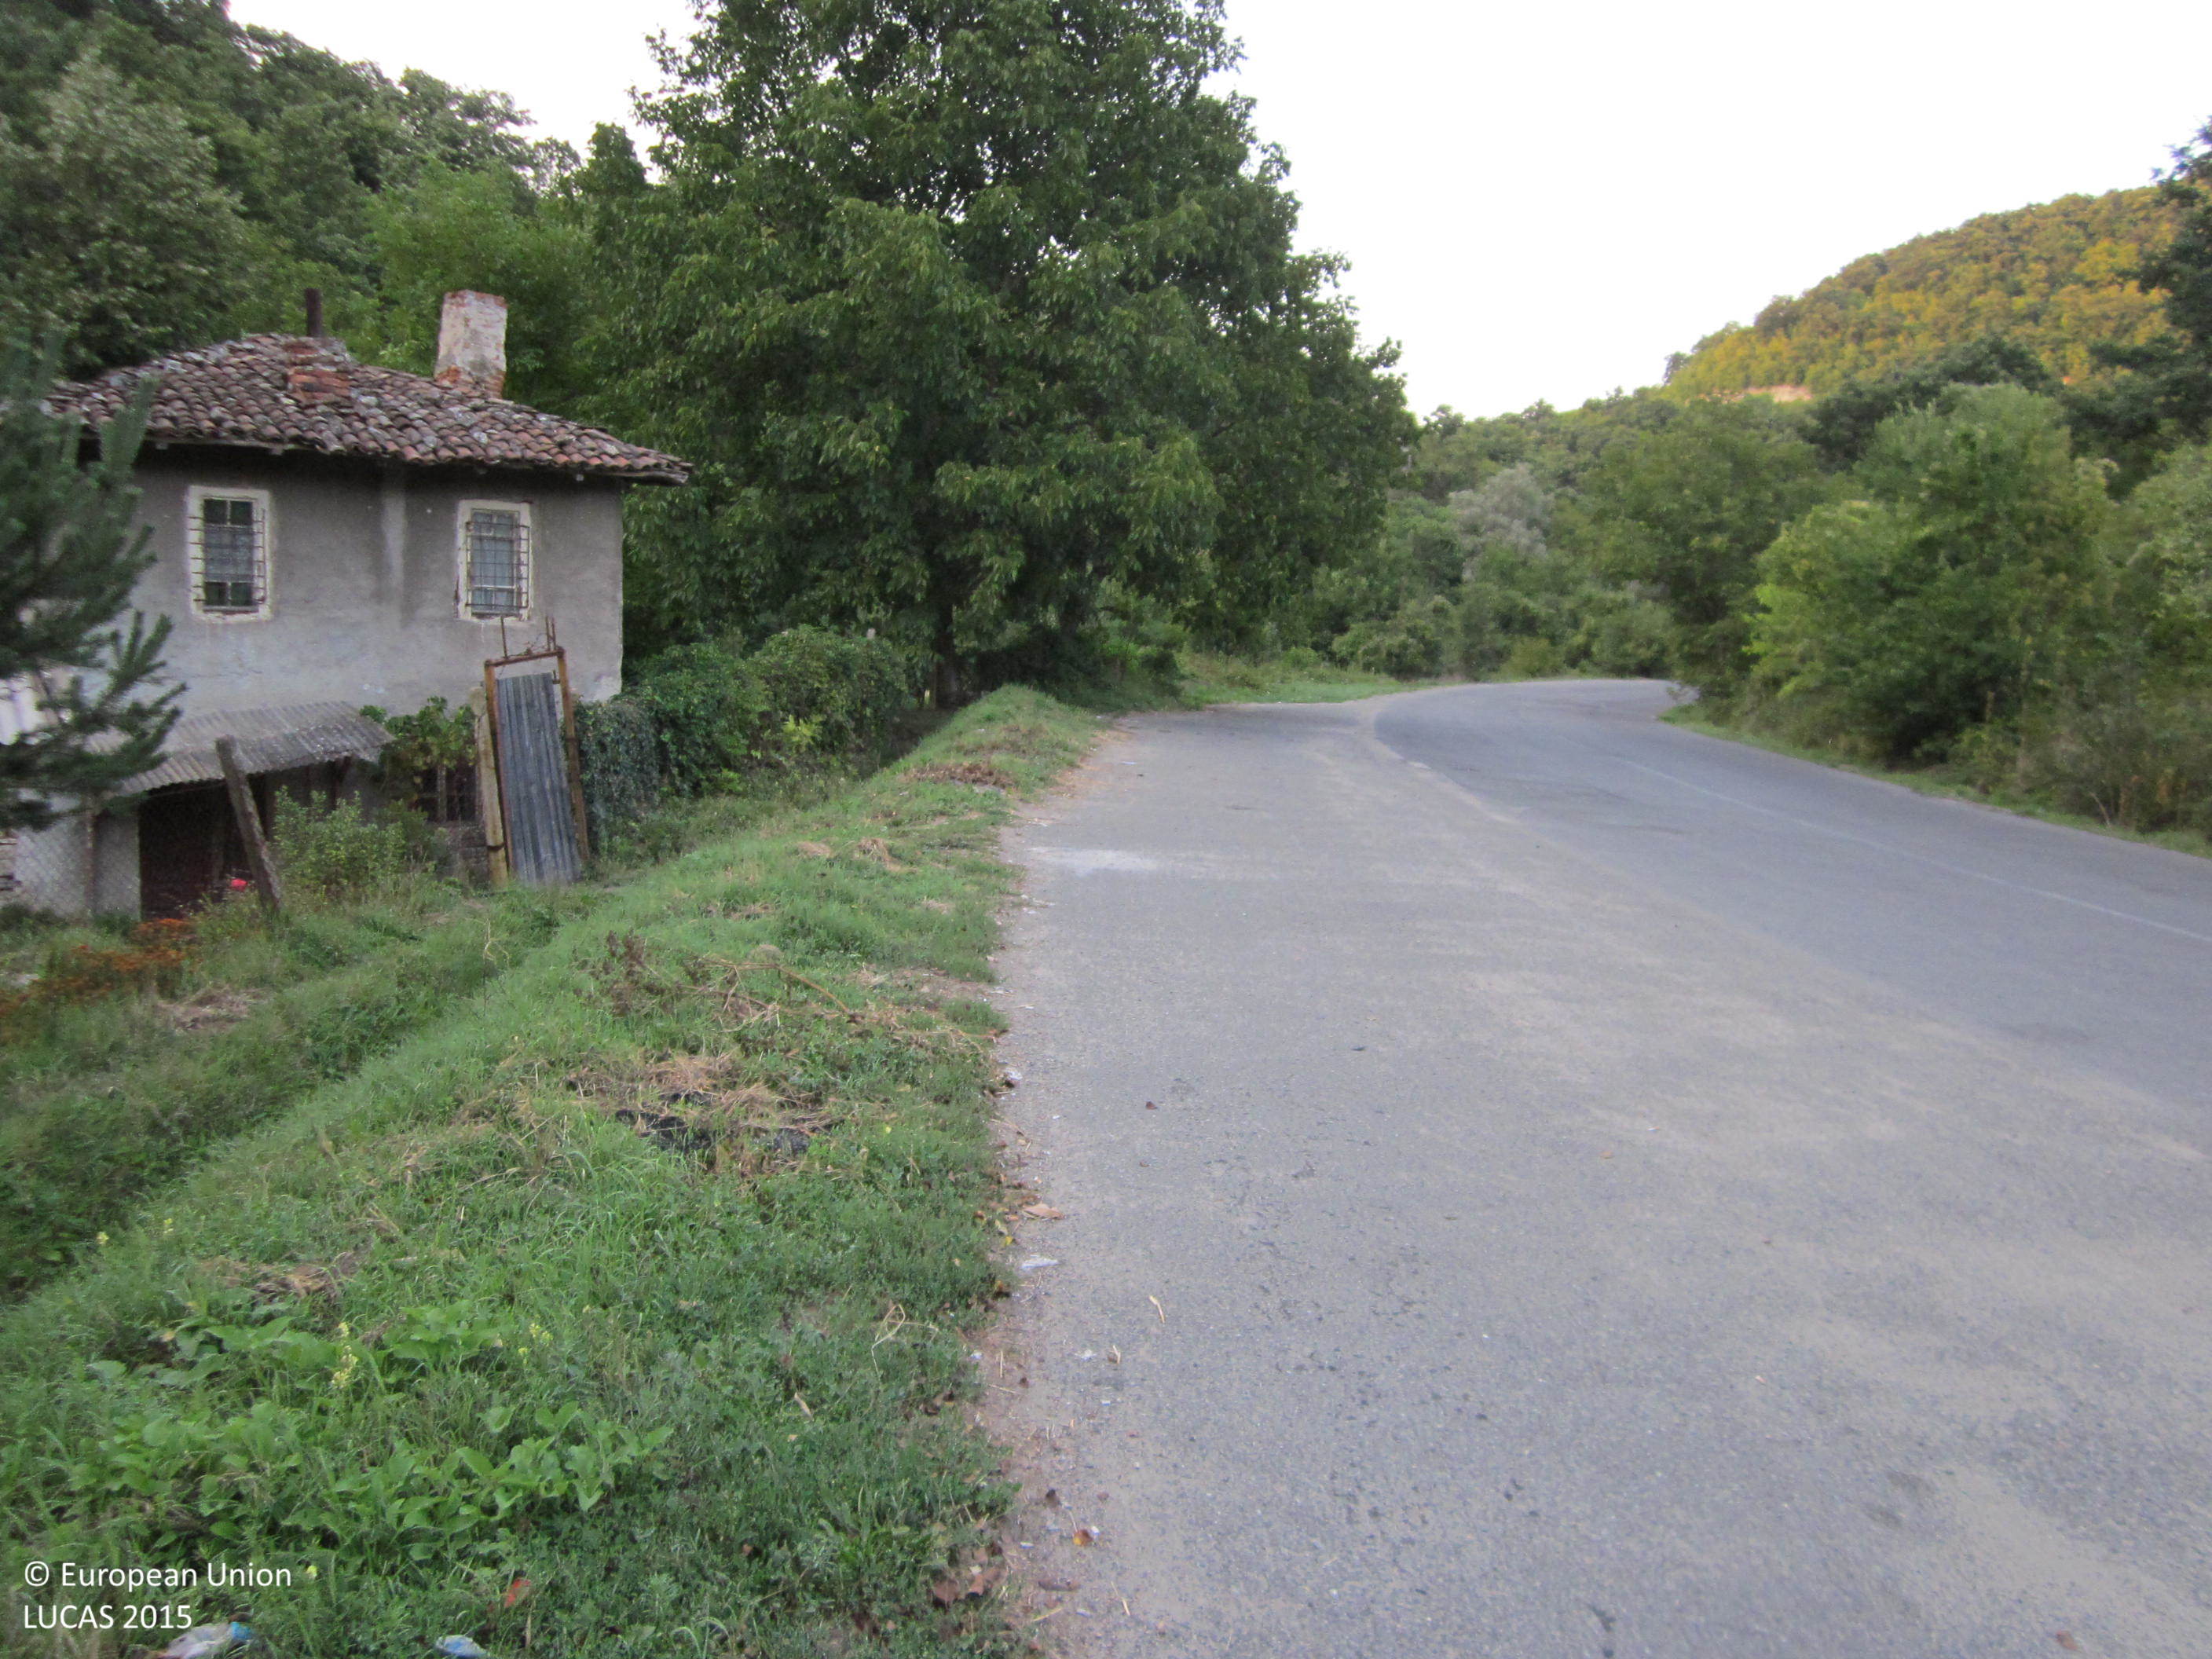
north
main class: Woodland
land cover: Broadleaved woodland
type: mesophytic deciduous forest
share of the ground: > 75 %
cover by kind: broadleaved forest trees 100 %
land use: Forestry
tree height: > 5 m
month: September
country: BG
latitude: 42.8486
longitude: 27.1843
